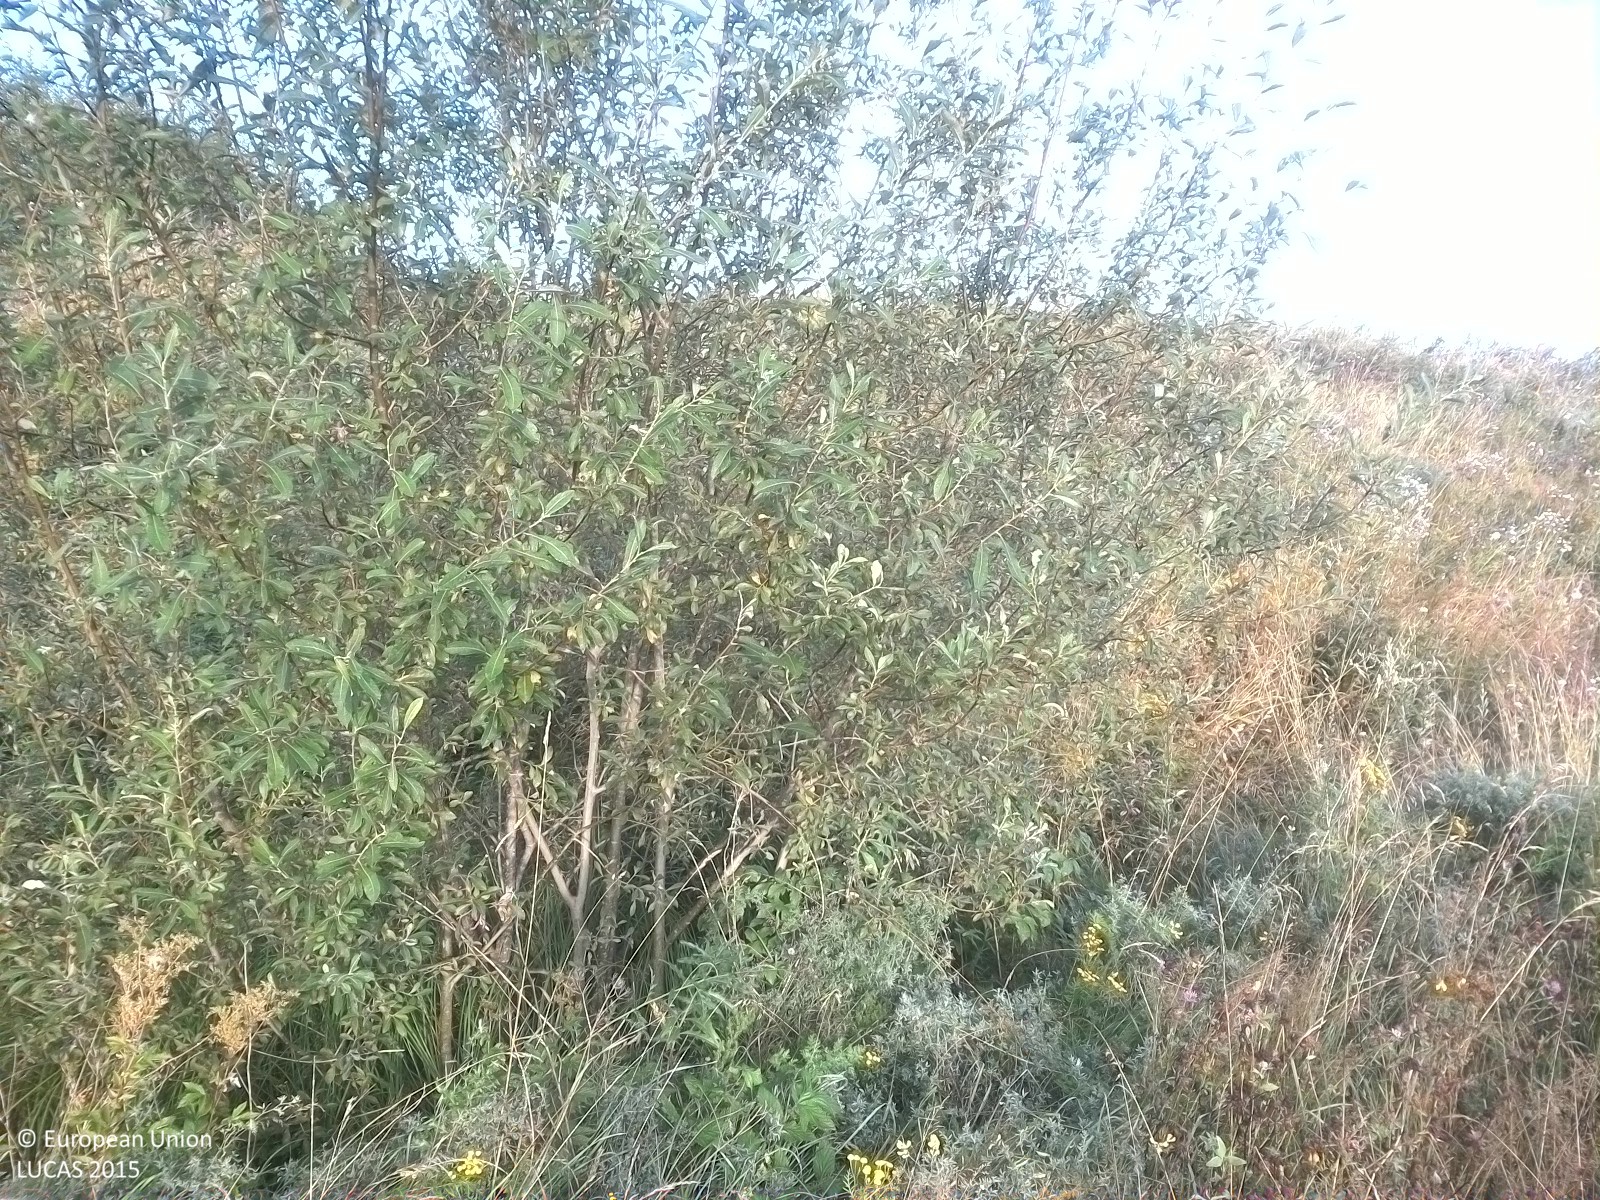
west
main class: Grassland
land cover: Spontaneously vegetated surfaces
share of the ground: > 75 %
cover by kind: herbaceous plants 100 %
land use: Fallow land
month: August
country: SE
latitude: 59.3324
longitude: 15.5285
